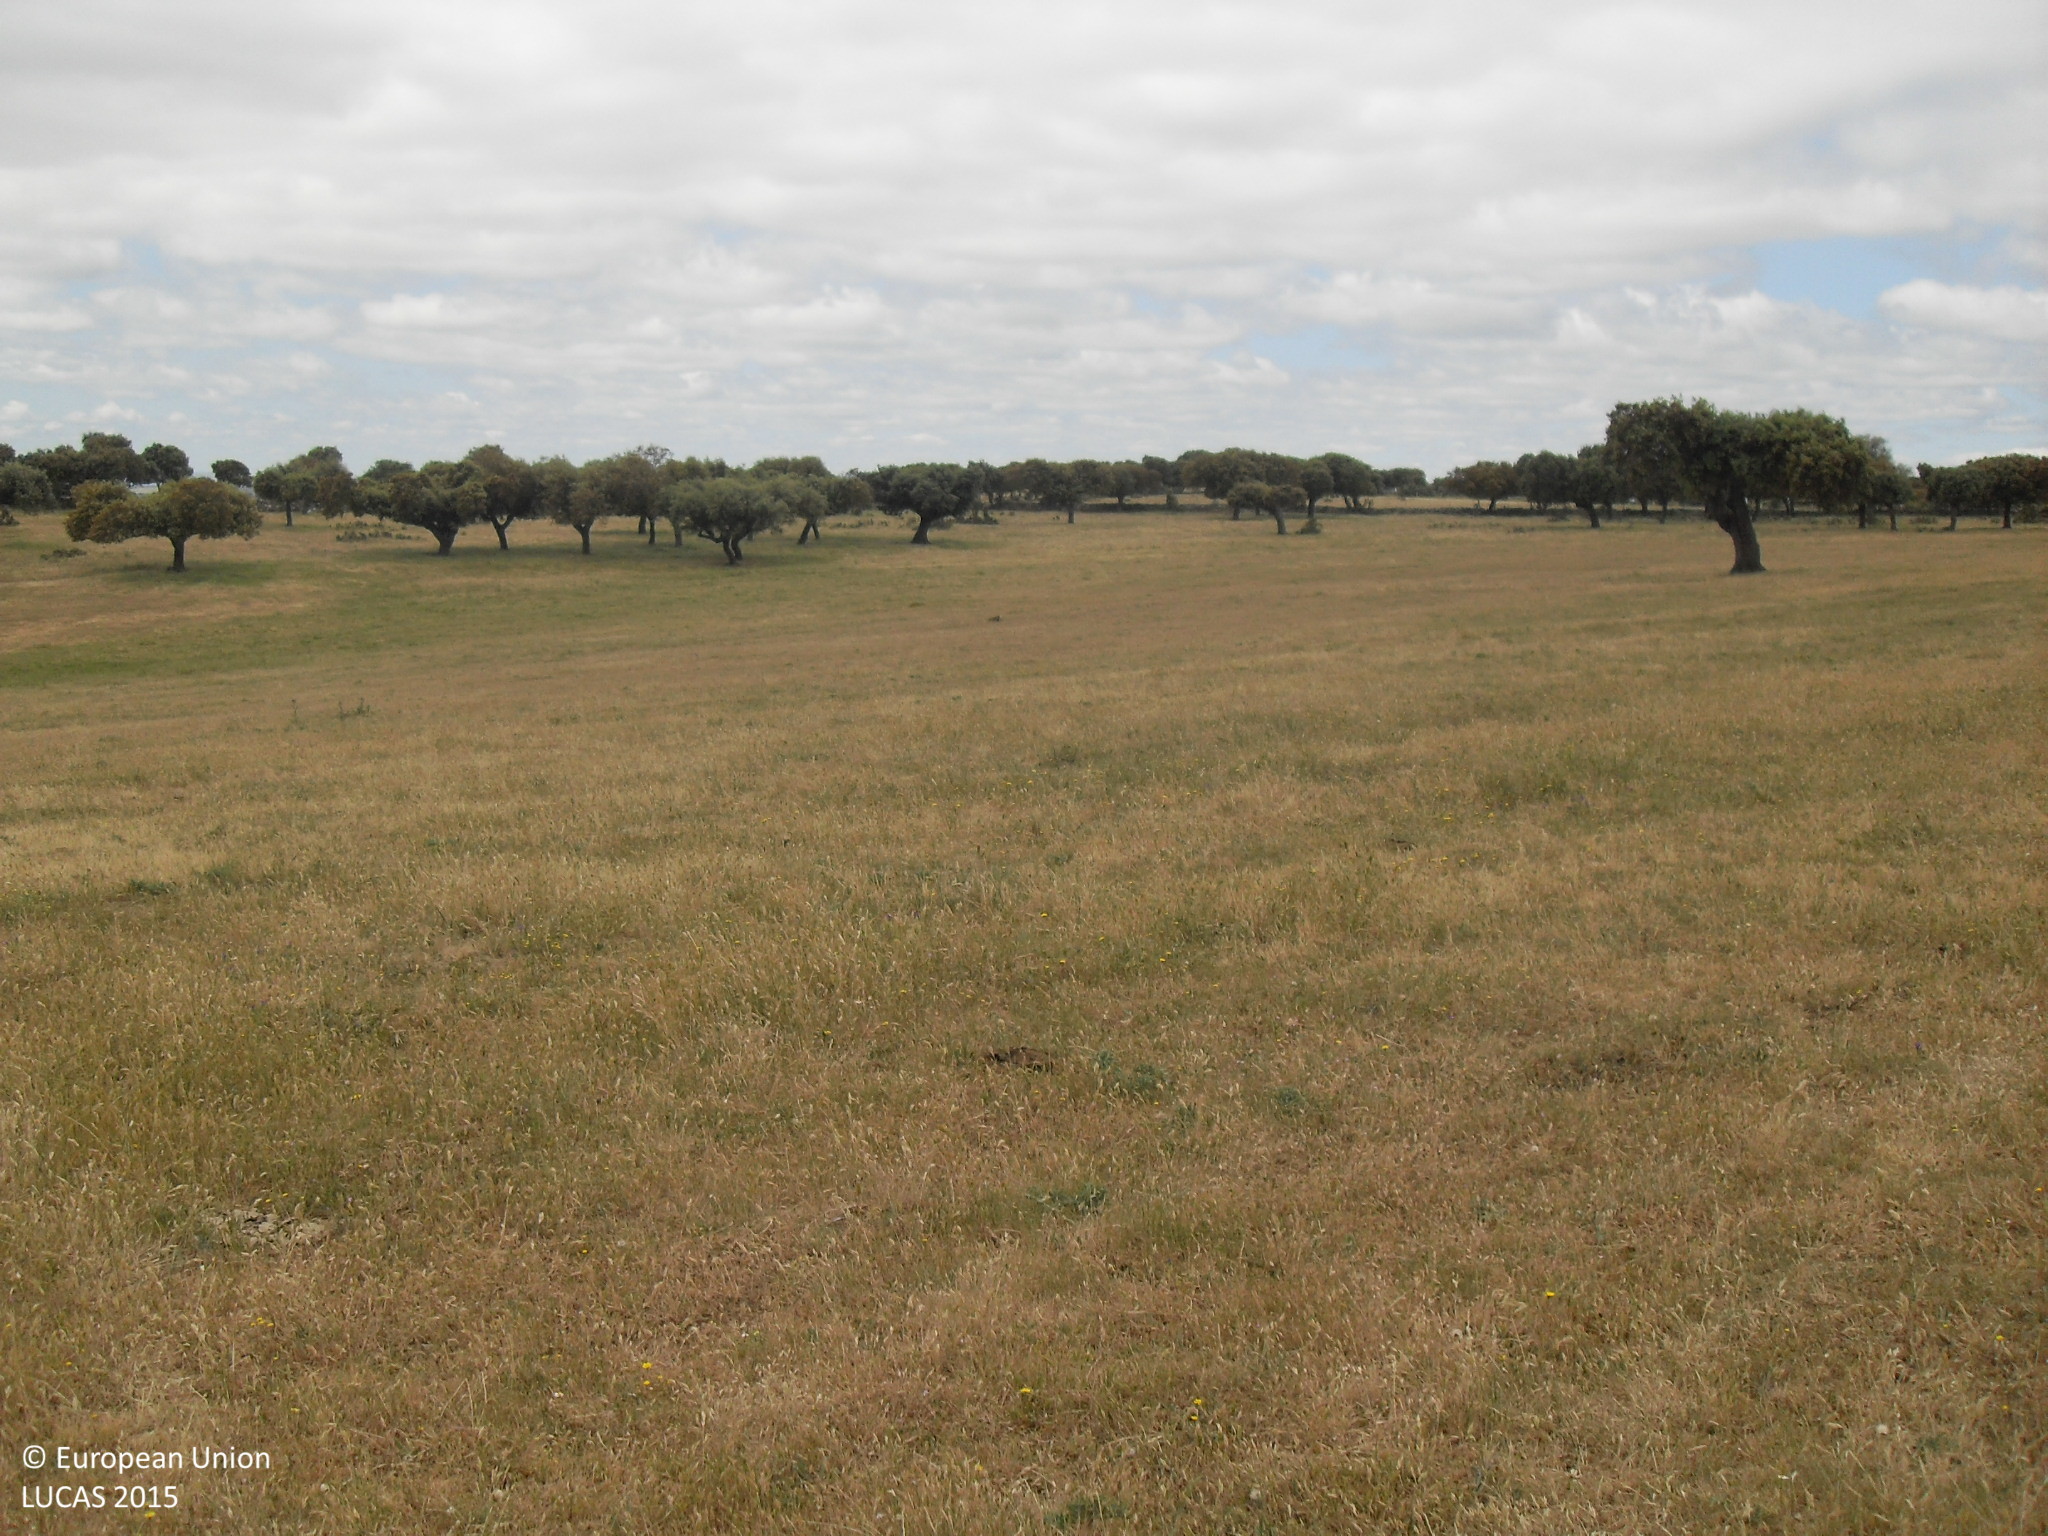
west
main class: Grassland
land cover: Grassland without tree/shrub cover
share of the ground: > 75 %
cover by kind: herbaceous plants 100 %
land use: Agriculture (excluding fallow land and kitchen gardens)
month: May
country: ES
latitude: 40.6081
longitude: -5.6127
